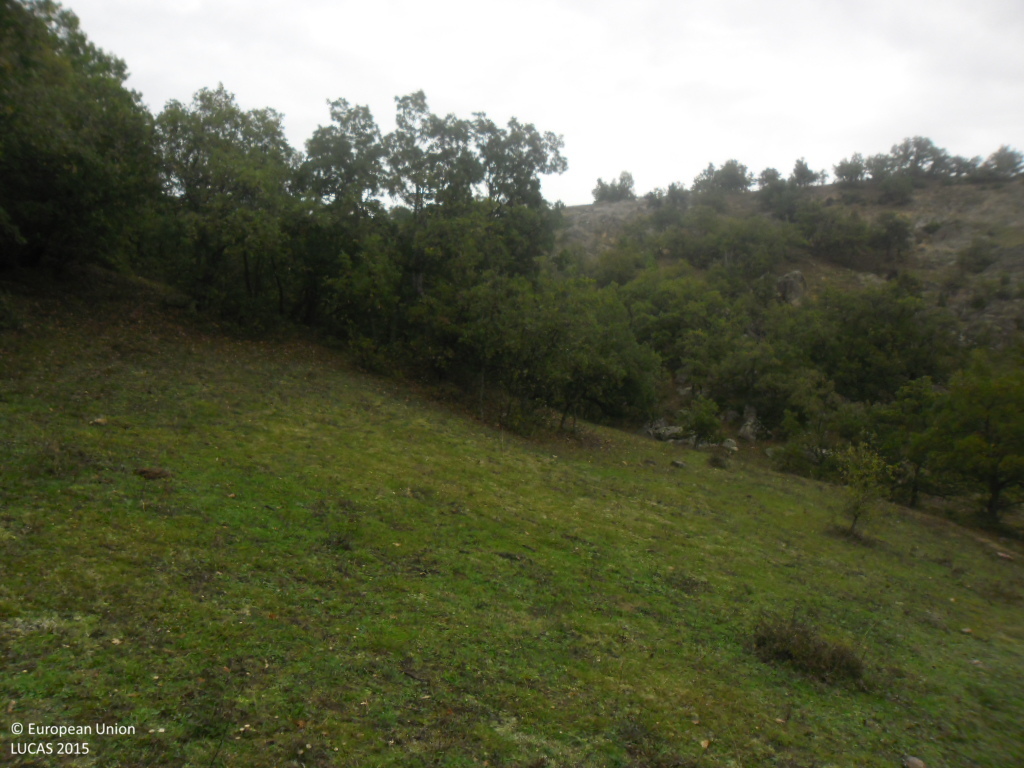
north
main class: Grassland
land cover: Grassland without tree/shrub cover
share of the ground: > 75 %
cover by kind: herbaceous plants 100 %
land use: Agriculture (excluding fallow land and kitchen gardens)
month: October
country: BG
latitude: 41.5520
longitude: 23.1723
